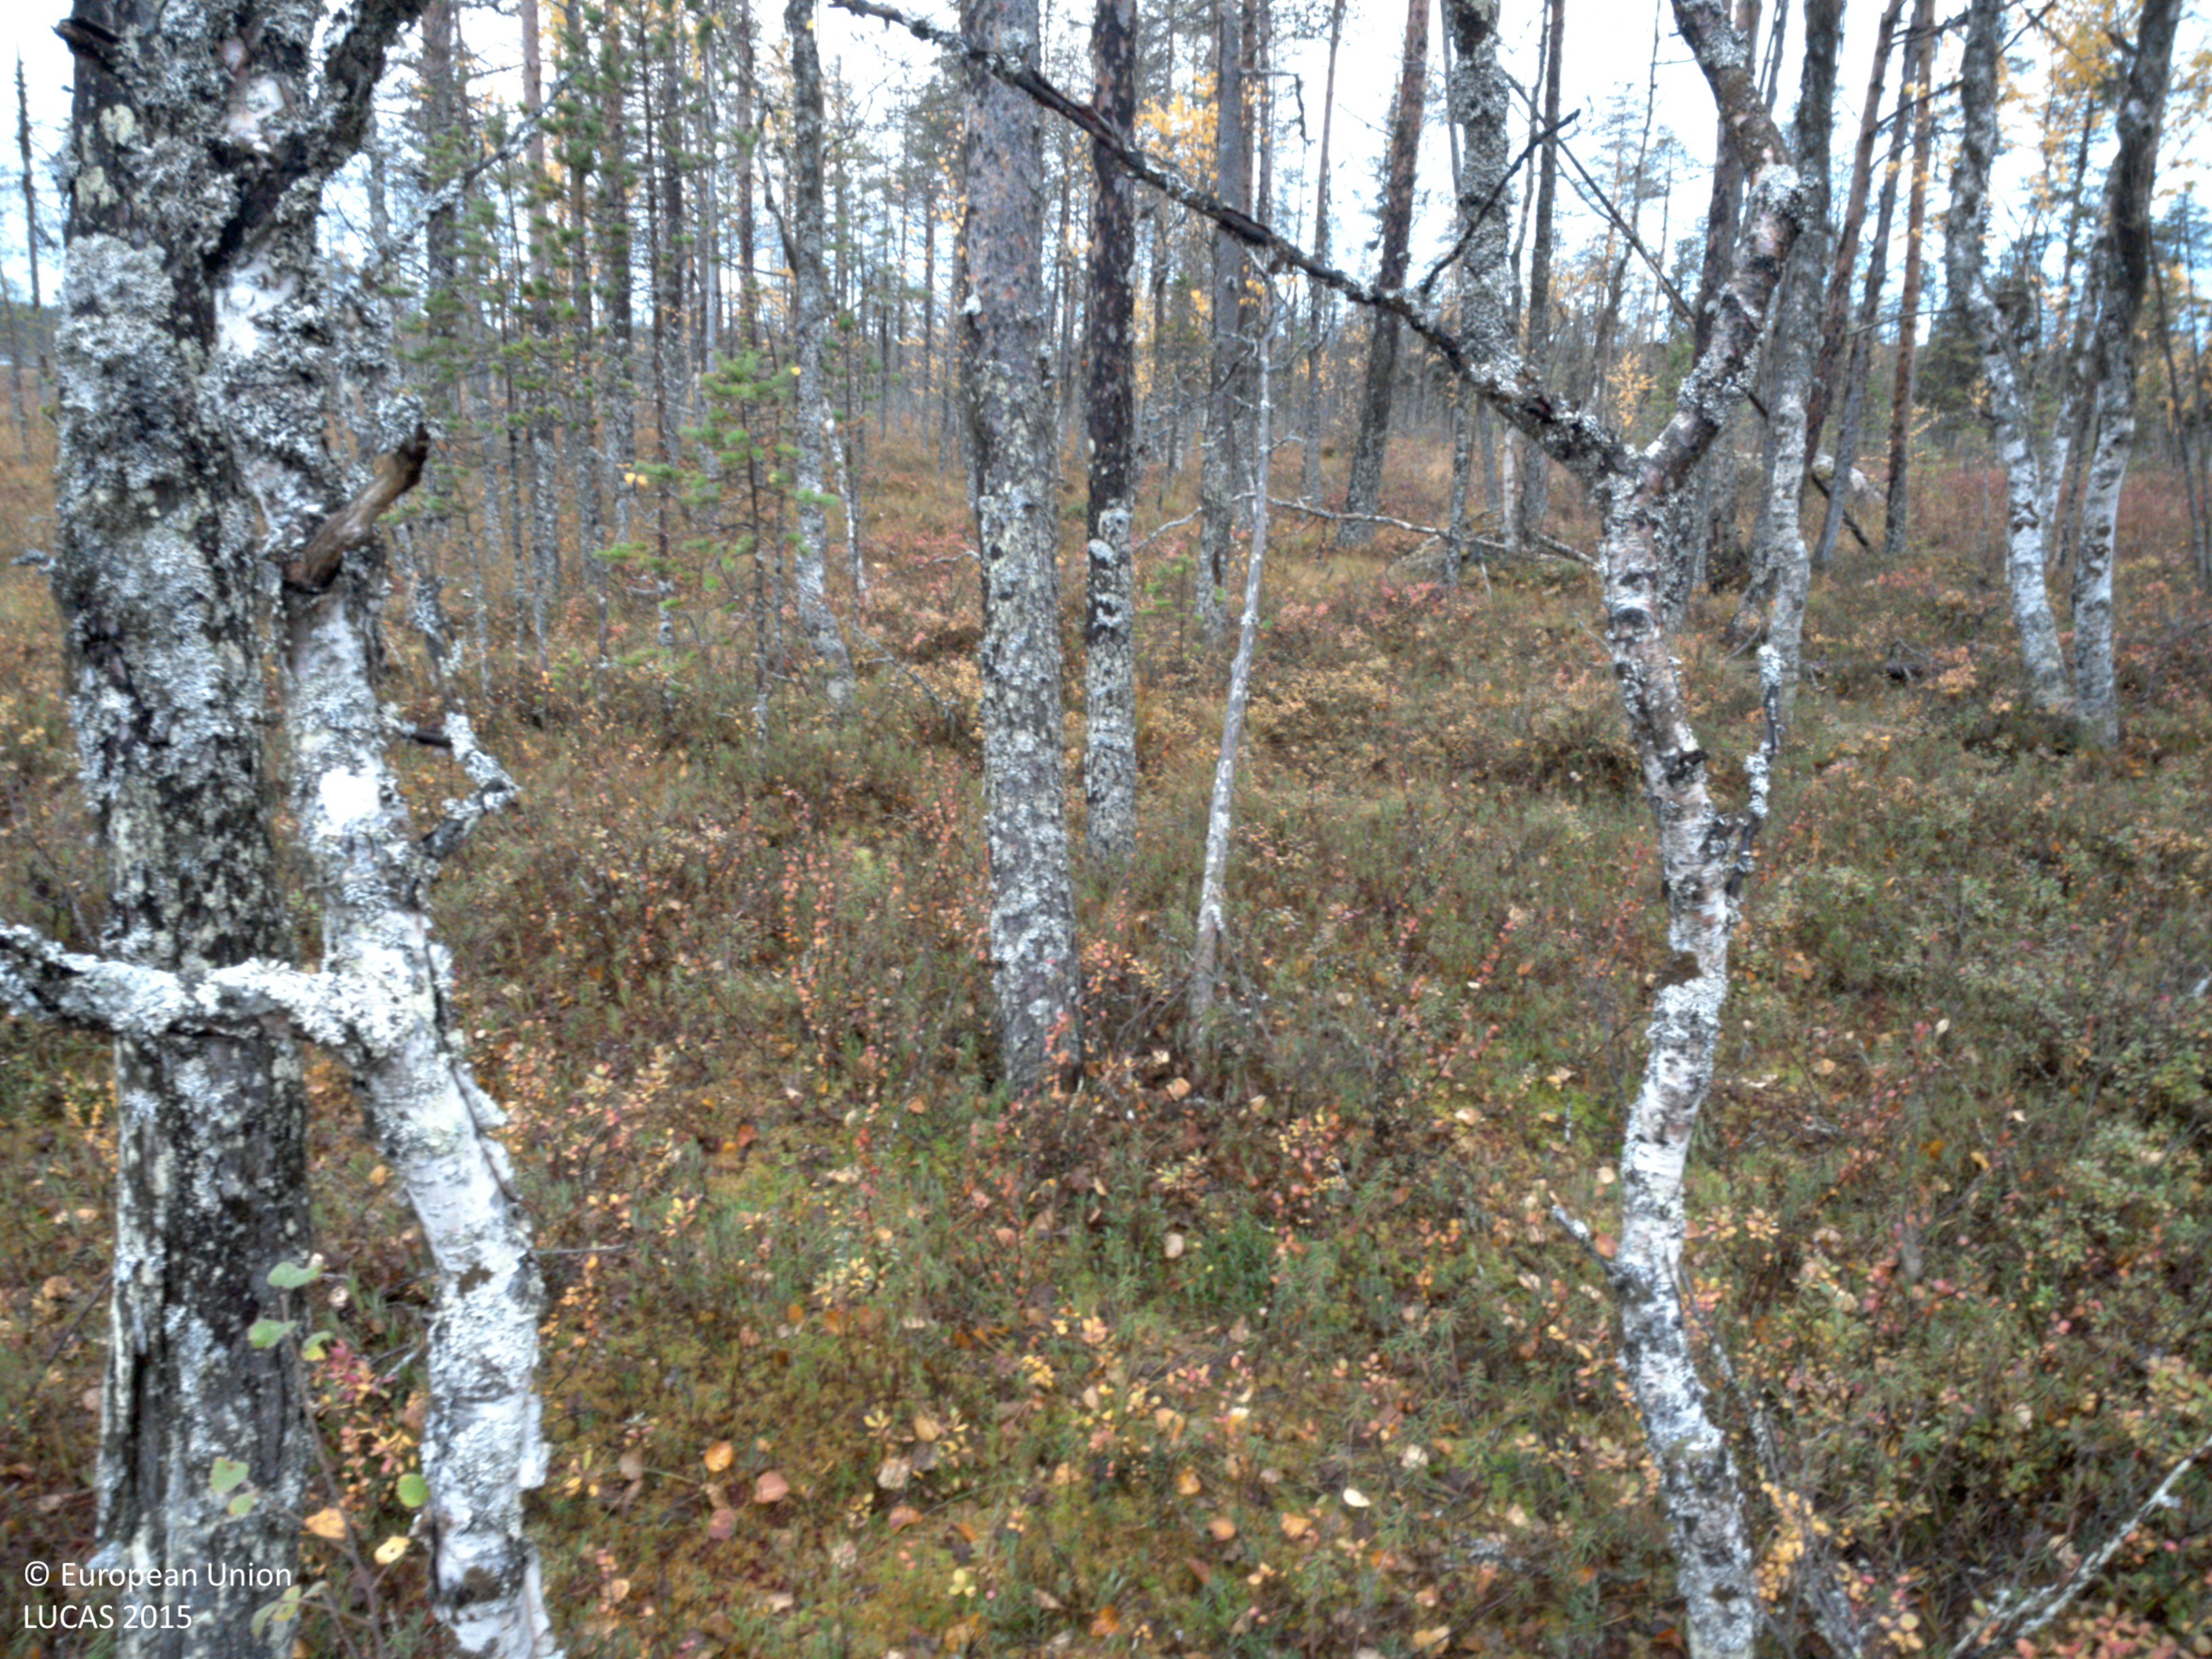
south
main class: Woodland
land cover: Pine dominated coniferous woodland
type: boreal forest
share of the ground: 25 - 50 %
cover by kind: shrubs 30 %, coniferous forest trees 25 %, herbaceous plants 20 %, lichens and mosses 20 %, broadleaved forest trees 5 %
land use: Forestry
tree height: < 5 m
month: September
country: SE
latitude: 65.0013
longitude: 18.9361
